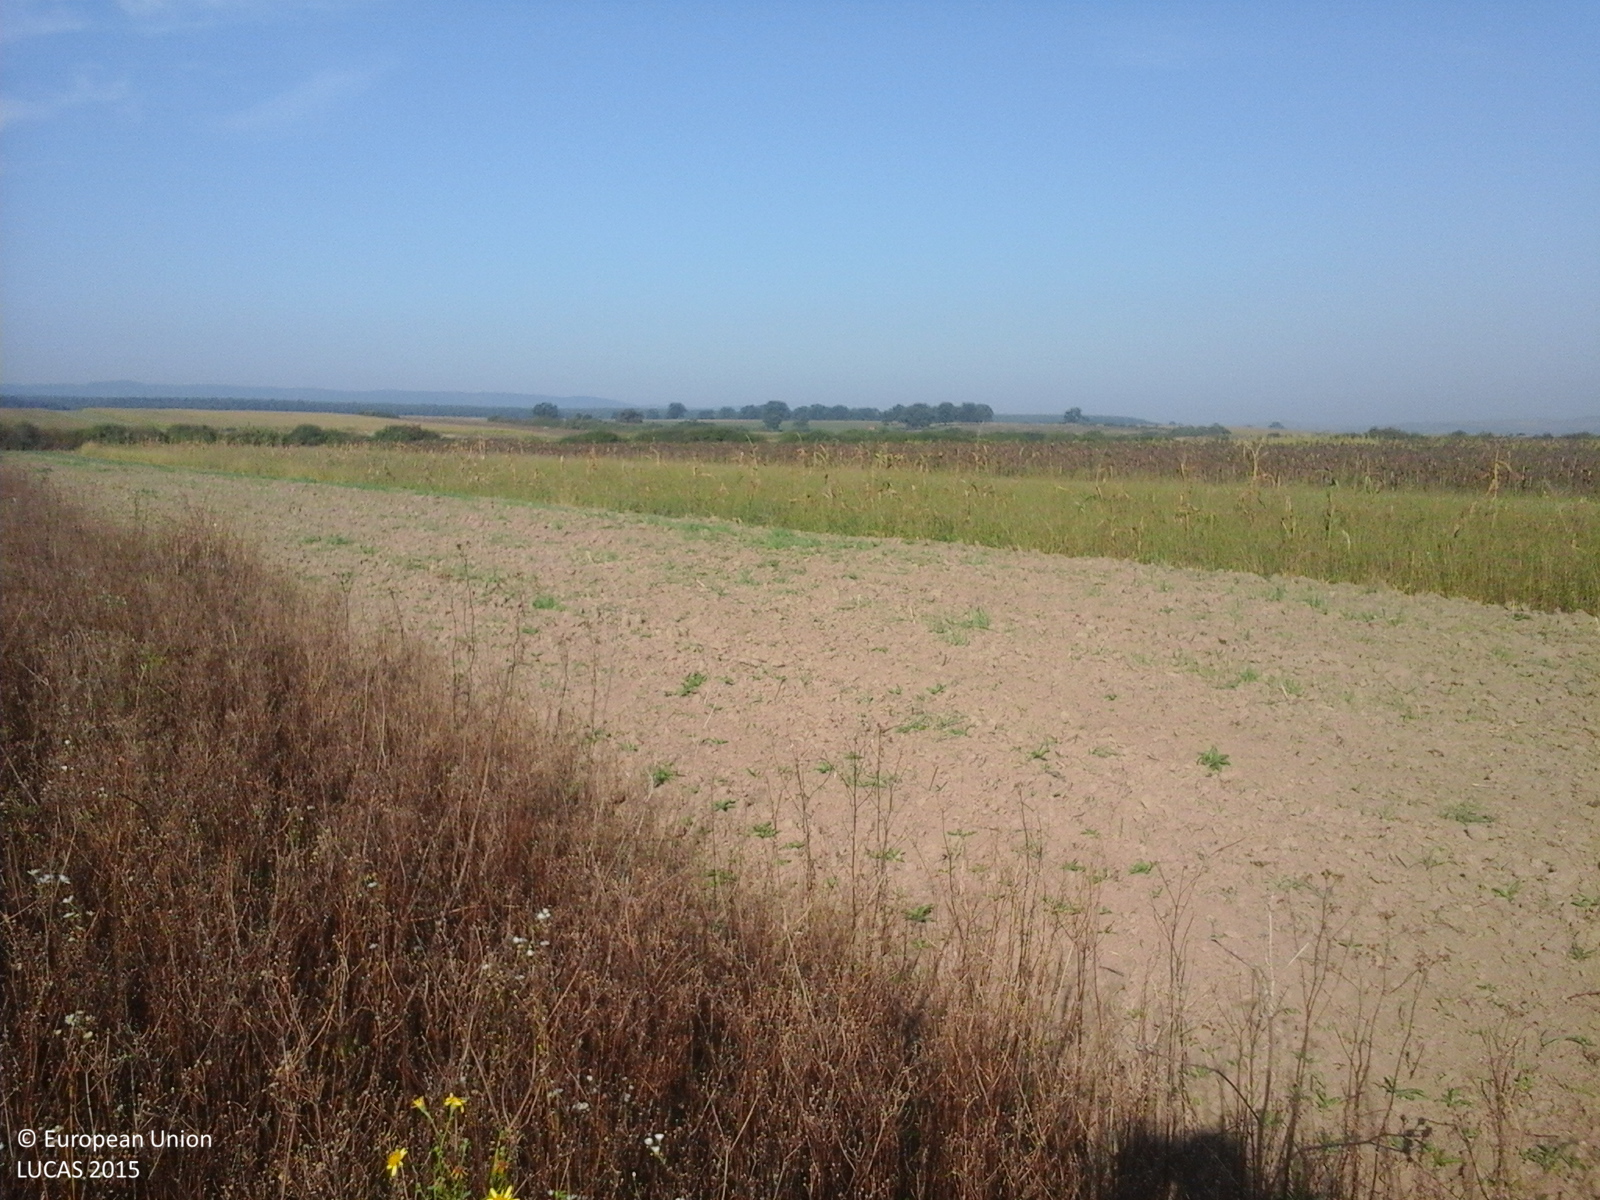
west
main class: Grassland
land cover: Spontaneously vegetated surfaces
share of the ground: > 75 %
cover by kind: herbaceous plants 100 %
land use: Agriculture (excluding fallow land and kitchen gardens)
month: September
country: RO
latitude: 47.1952
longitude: 22.6899
